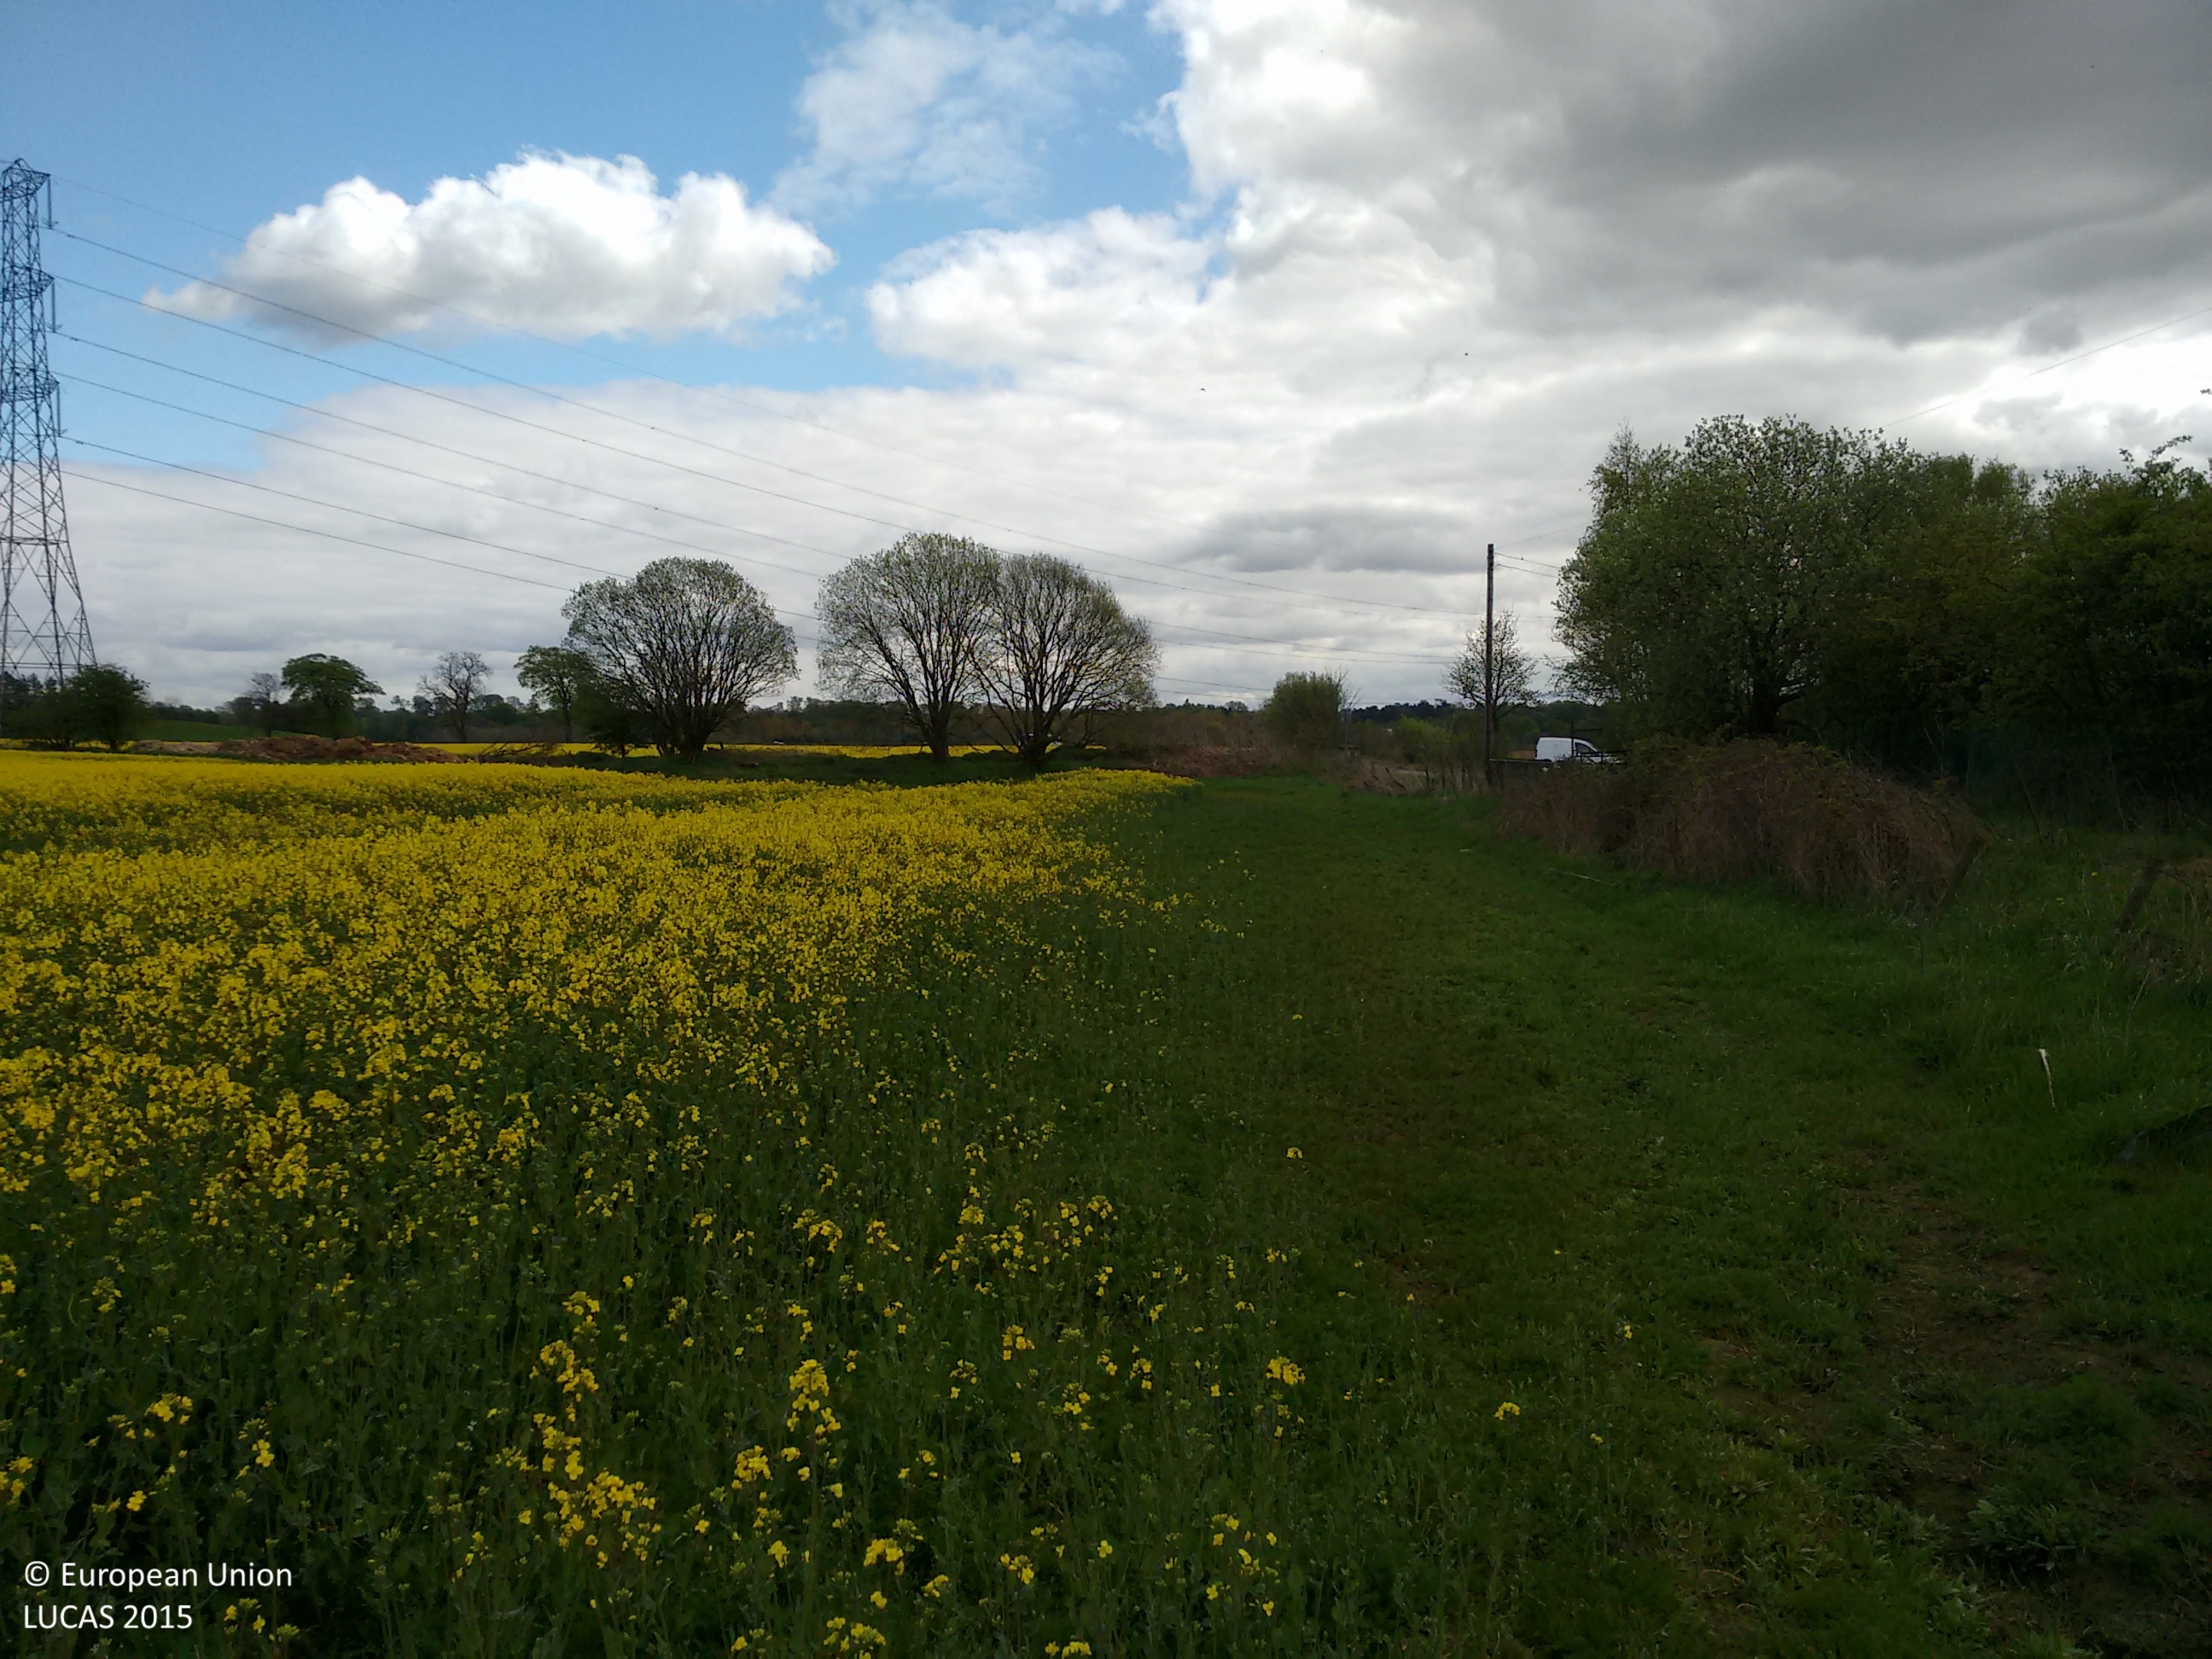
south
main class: Cropland
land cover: Rape and turnip rape
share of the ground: > 75 %
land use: Agriculture (excluding fallow land and kitchen gardens)
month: May
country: GB
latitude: 55.9379
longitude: -4.2284
